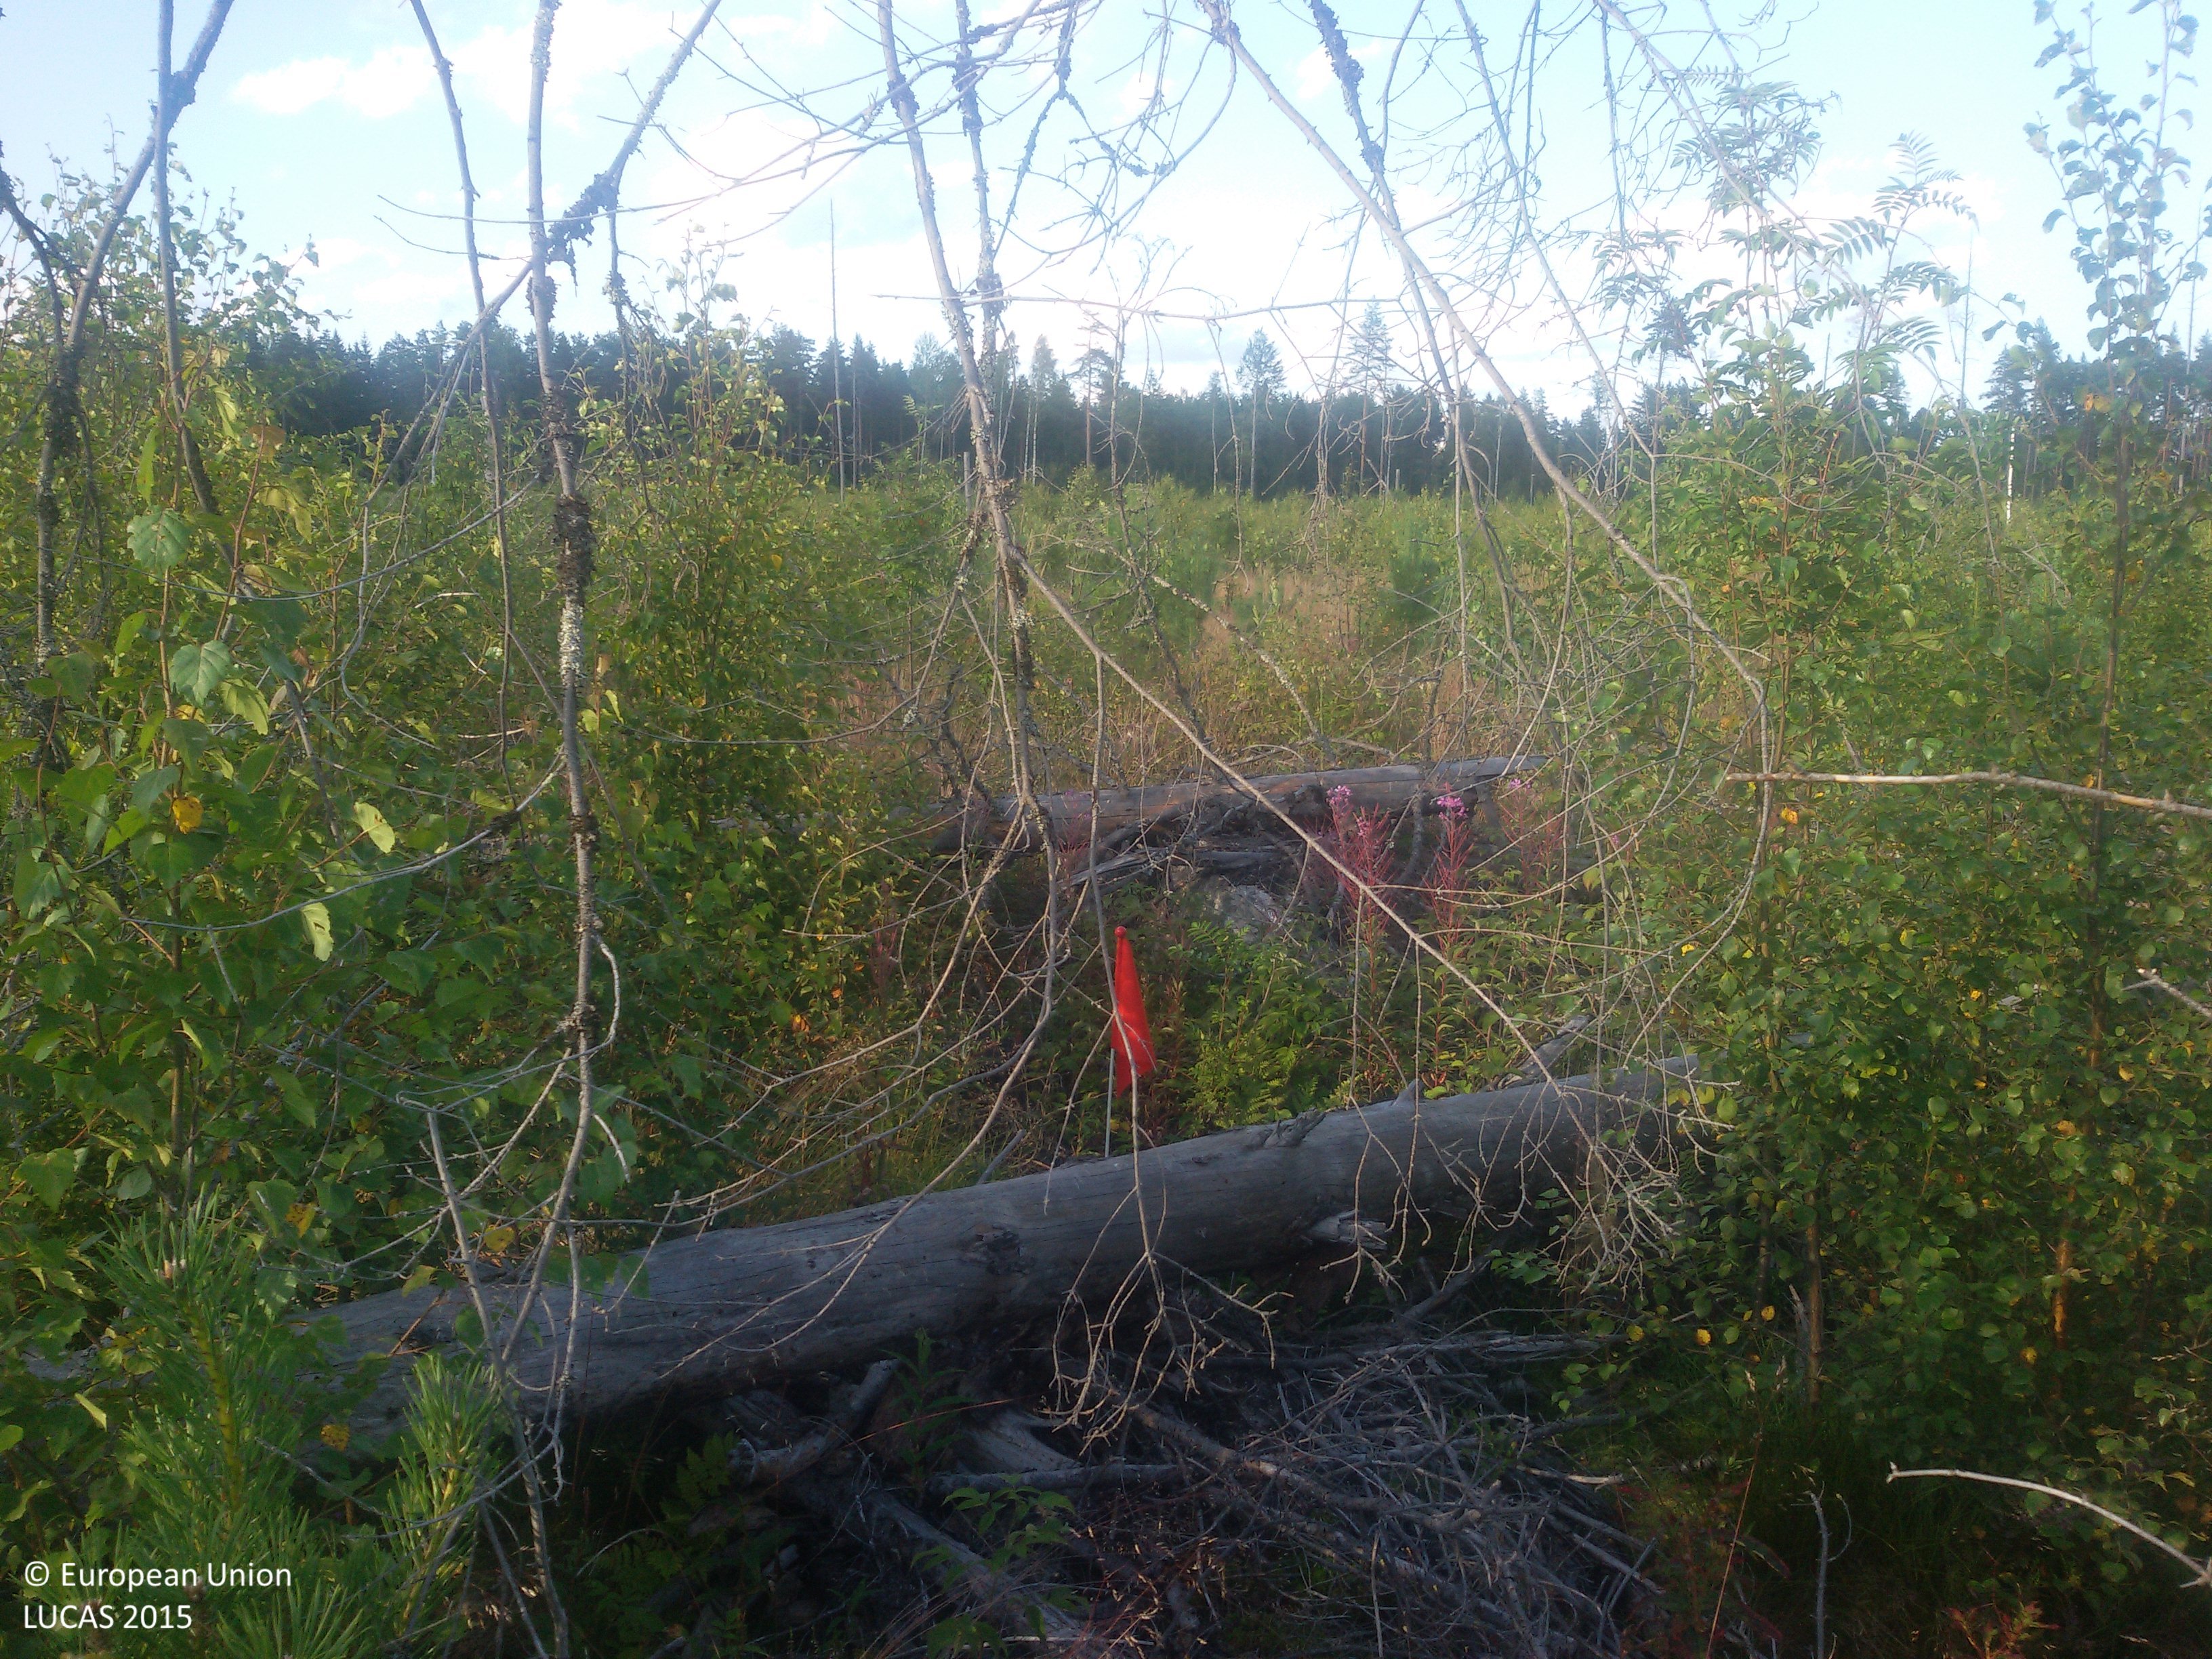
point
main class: Woodland
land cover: Pine dominated mixed woodland
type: boreal forest
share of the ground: > 75 %
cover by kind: broadleaved forest trees 45 %, coniferous forest trees 30 %, herbaceous plants 25 %
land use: Forestry
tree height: < 5 m
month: August
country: SE
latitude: 60.6183
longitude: 16.6942
